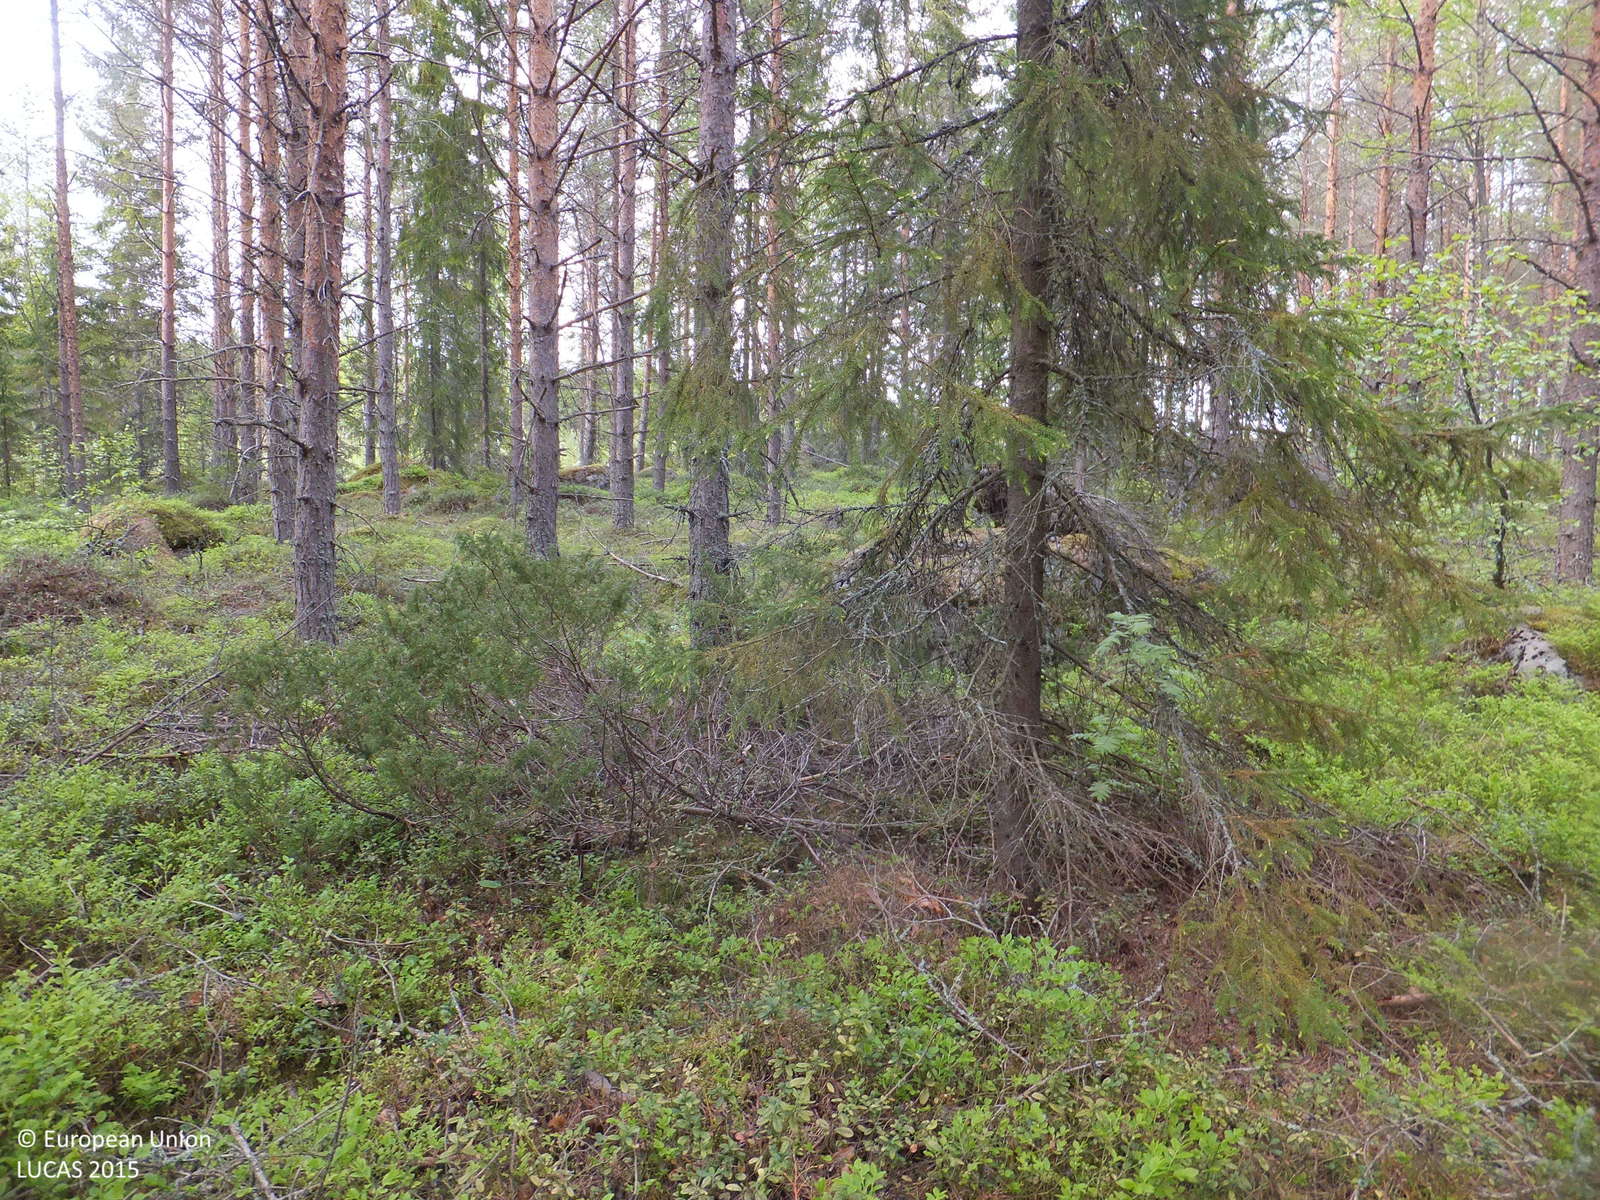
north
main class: Woodland
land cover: Pine dominated coniferous woodland
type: boreal forest
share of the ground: > 75 %
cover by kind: coniferous forest trees 95 %, lichens and mosses 5 %
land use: Forestry
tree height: > 5 m
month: June
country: FI
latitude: 63.5483
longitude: 22.3392
